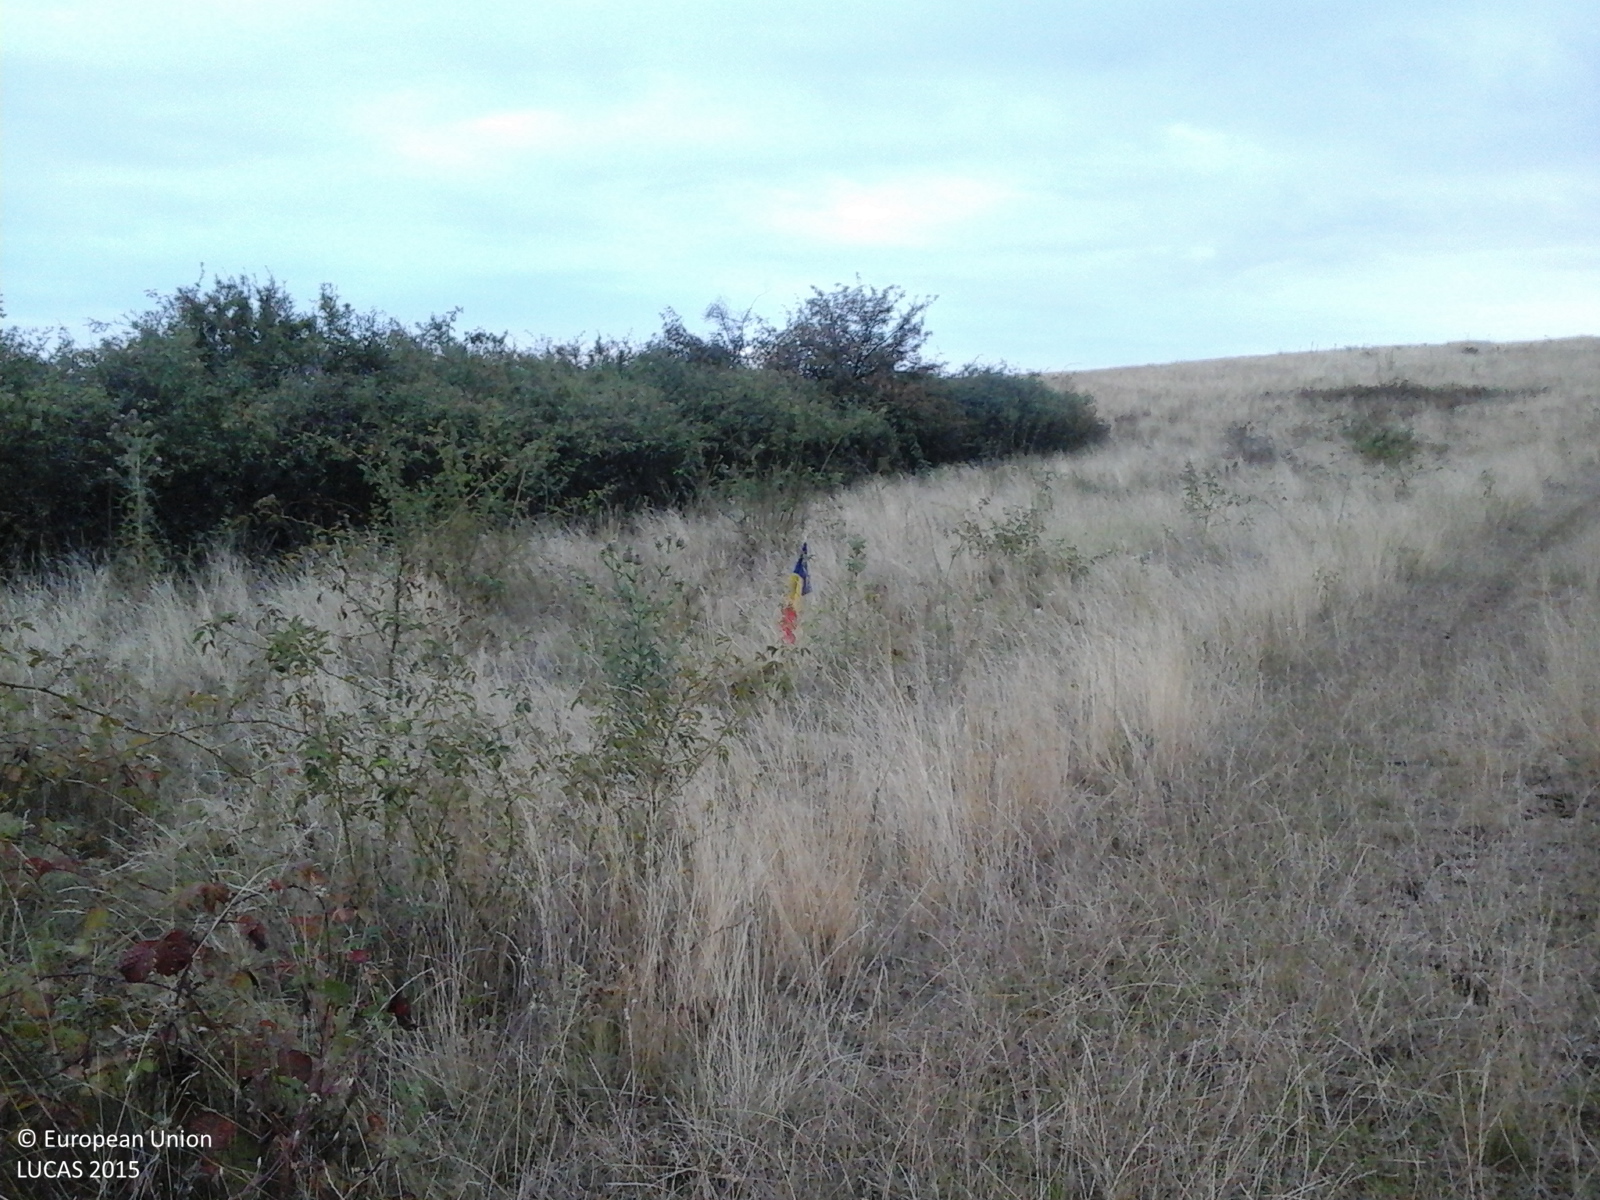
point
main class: Grassland
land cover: Grassland with sparse tree/shrub cover
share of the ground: > 75 %
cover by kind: herbaceous plants 85 %, shrubs 10 %, broadleaved forest trees 5 %
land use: Agriculture (excluding fallow land and kitchen gardens)
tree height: < 5 m
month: August
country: RO
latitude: 45.8317
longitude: 21.5566
